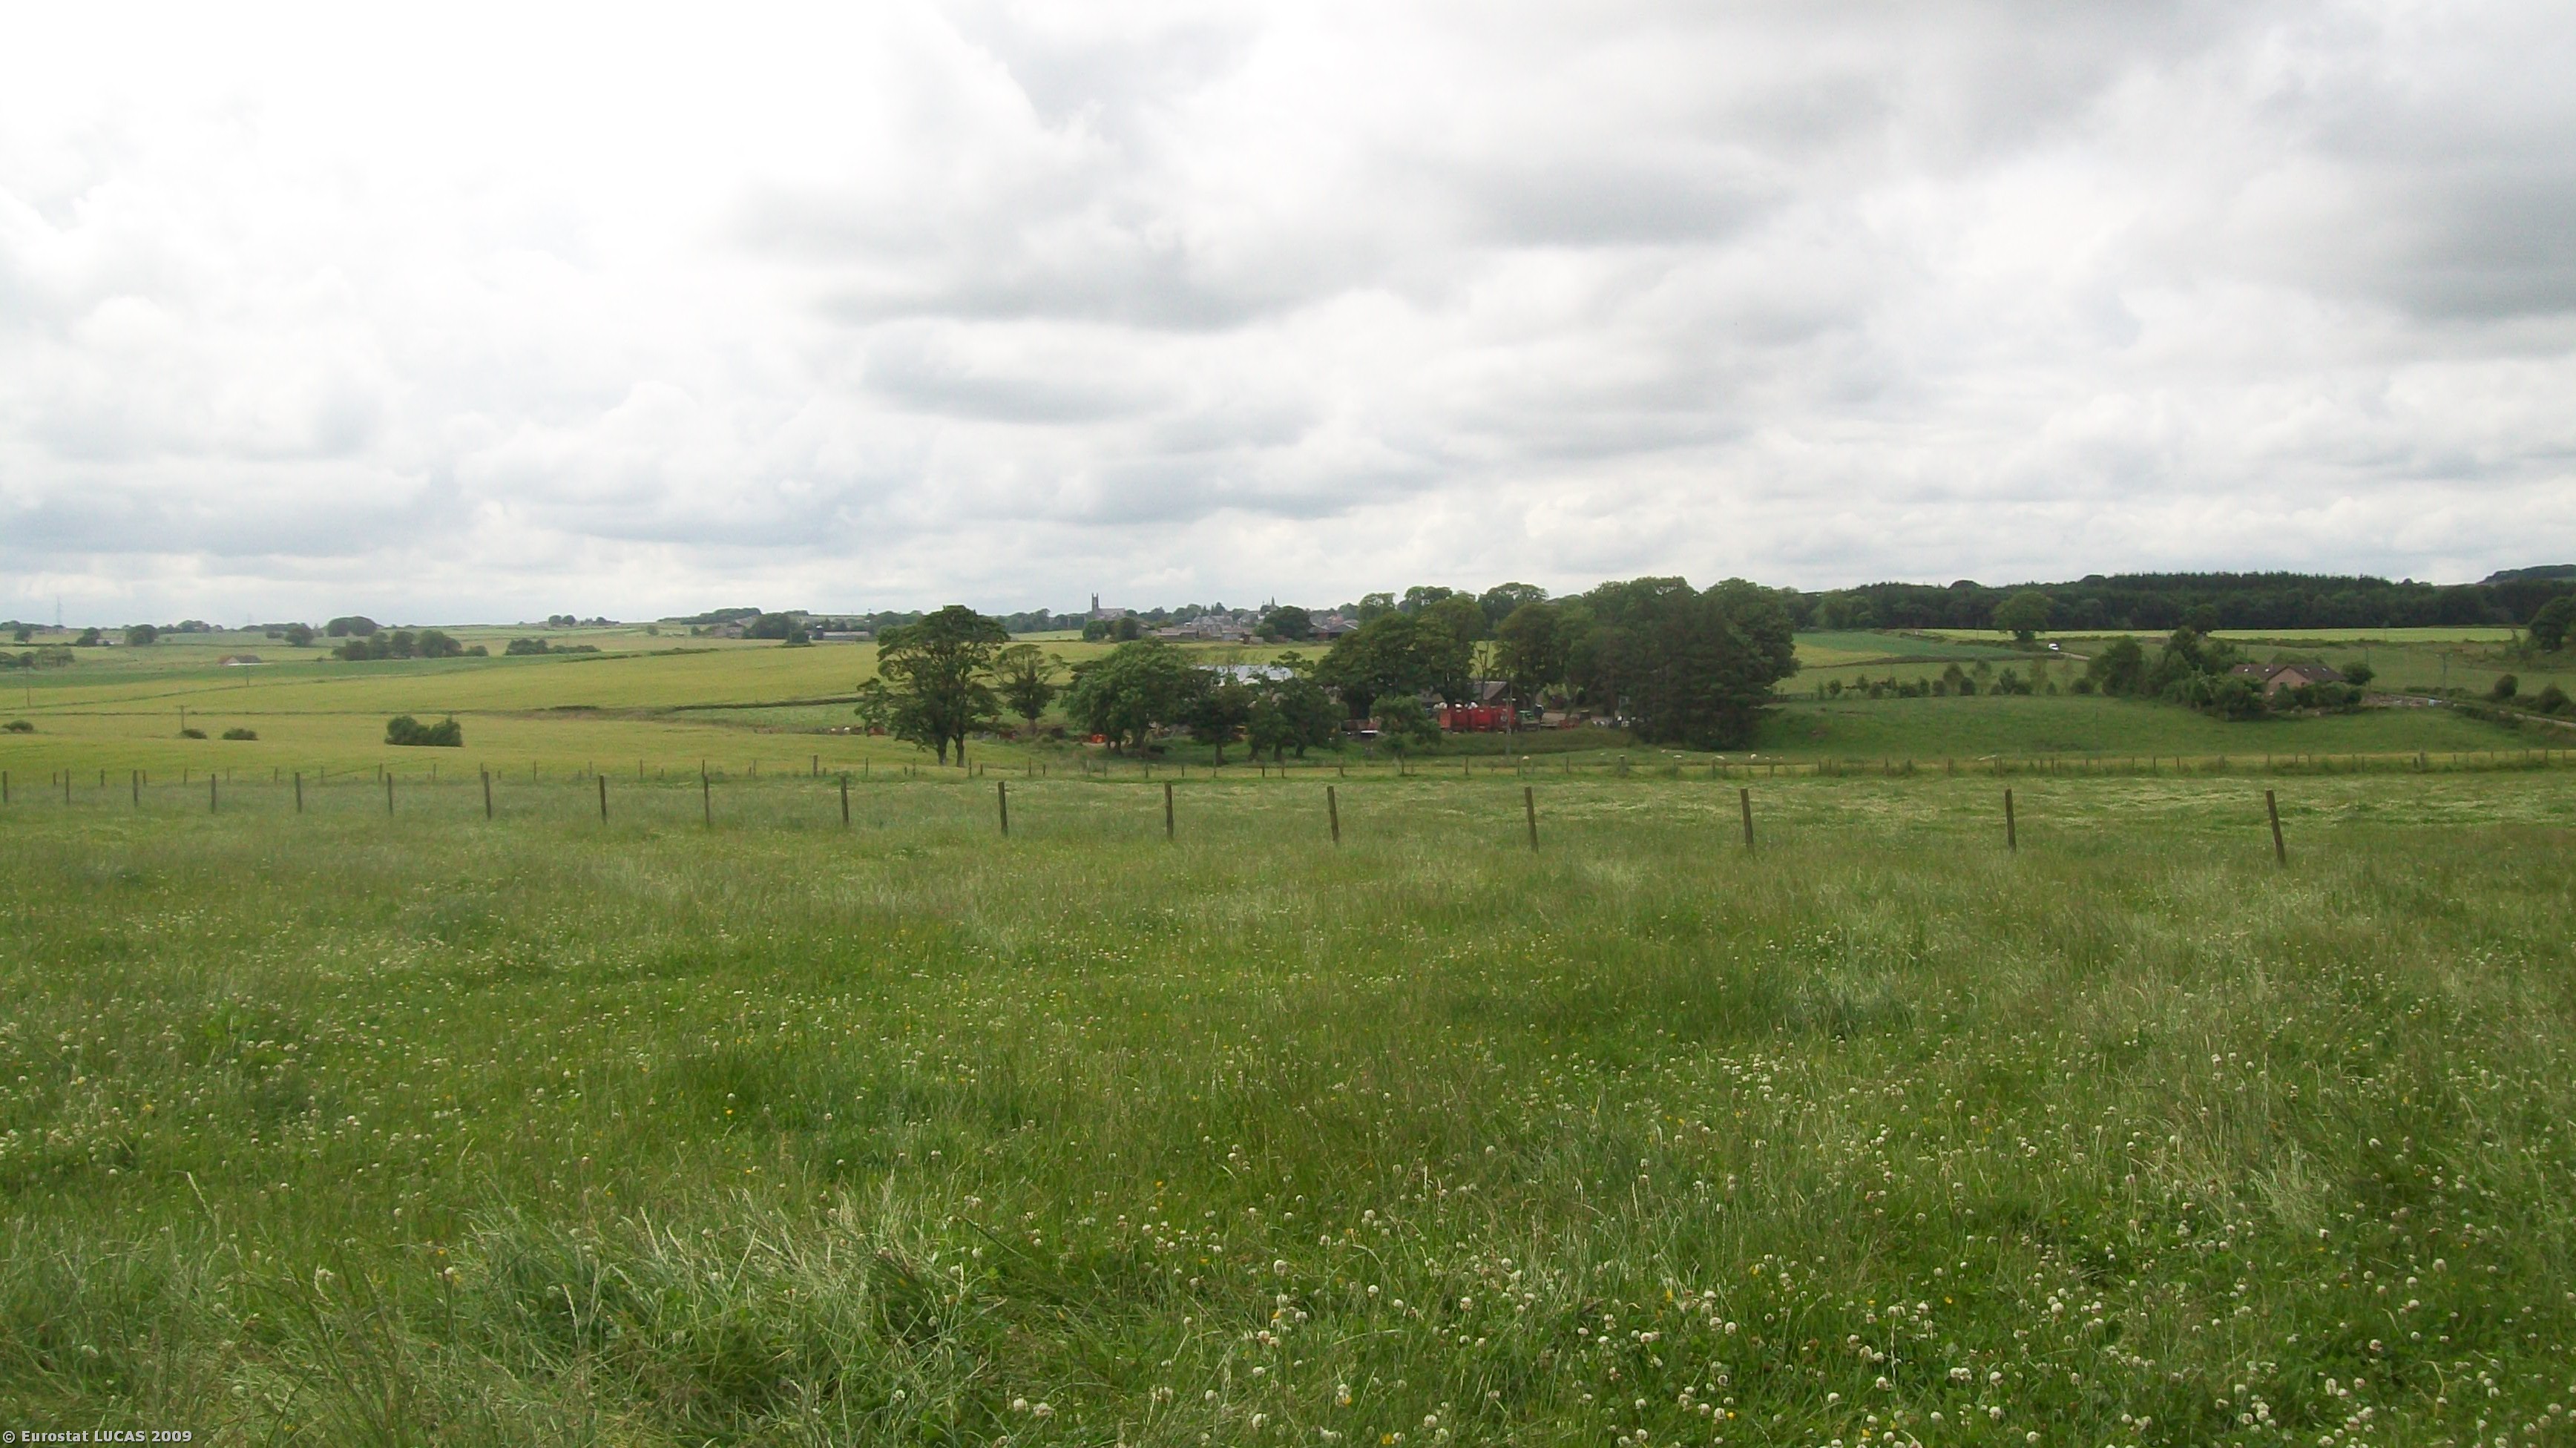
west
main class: Grassland
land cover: Grassland without tree/shrub cover
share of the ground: > 75 %
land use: Agriculture (excluding fallow land and kitchen gardens)
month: July
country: GB
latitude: 57.5198
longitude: -2.1520
